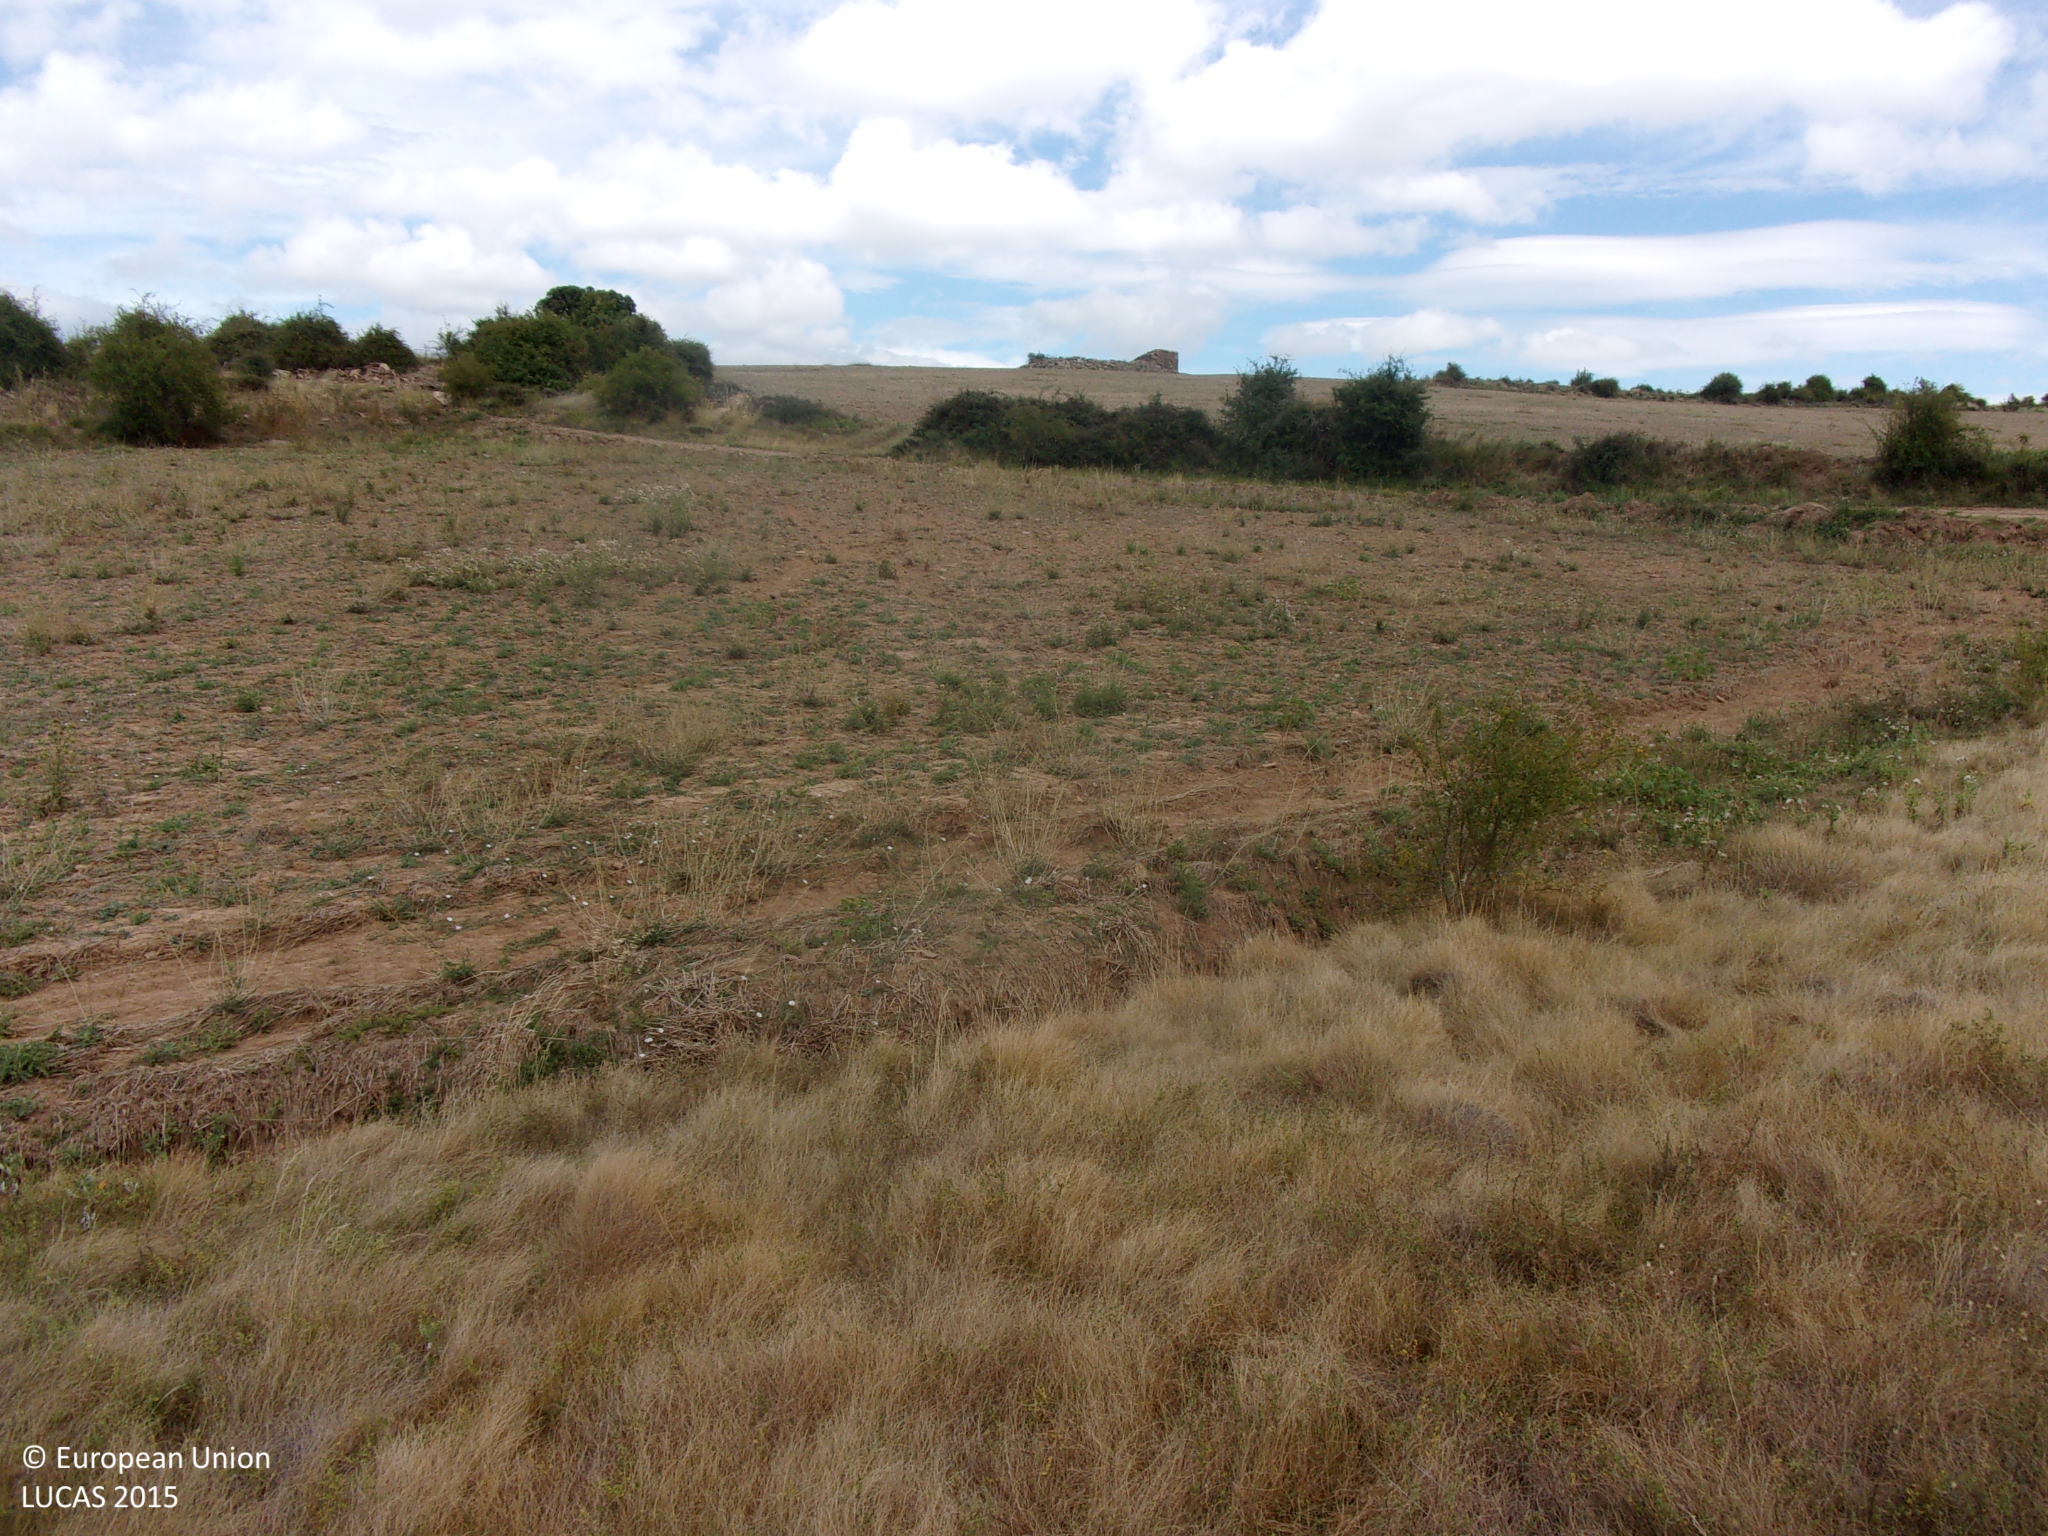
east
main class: Grassland
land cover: Grassland without tree/shrub cover
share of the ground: > 75 %
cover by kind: herbaceous plants 100 %
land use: Abandoned areas
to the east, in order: Grassland without tree/shrub cover; Spontaneously vegetated surfaces; Grass margins; Tracks; Shruby margins; Spontaneously vegetated surfaces
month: August
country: ES
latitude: 42.5669
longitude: -1.1293
